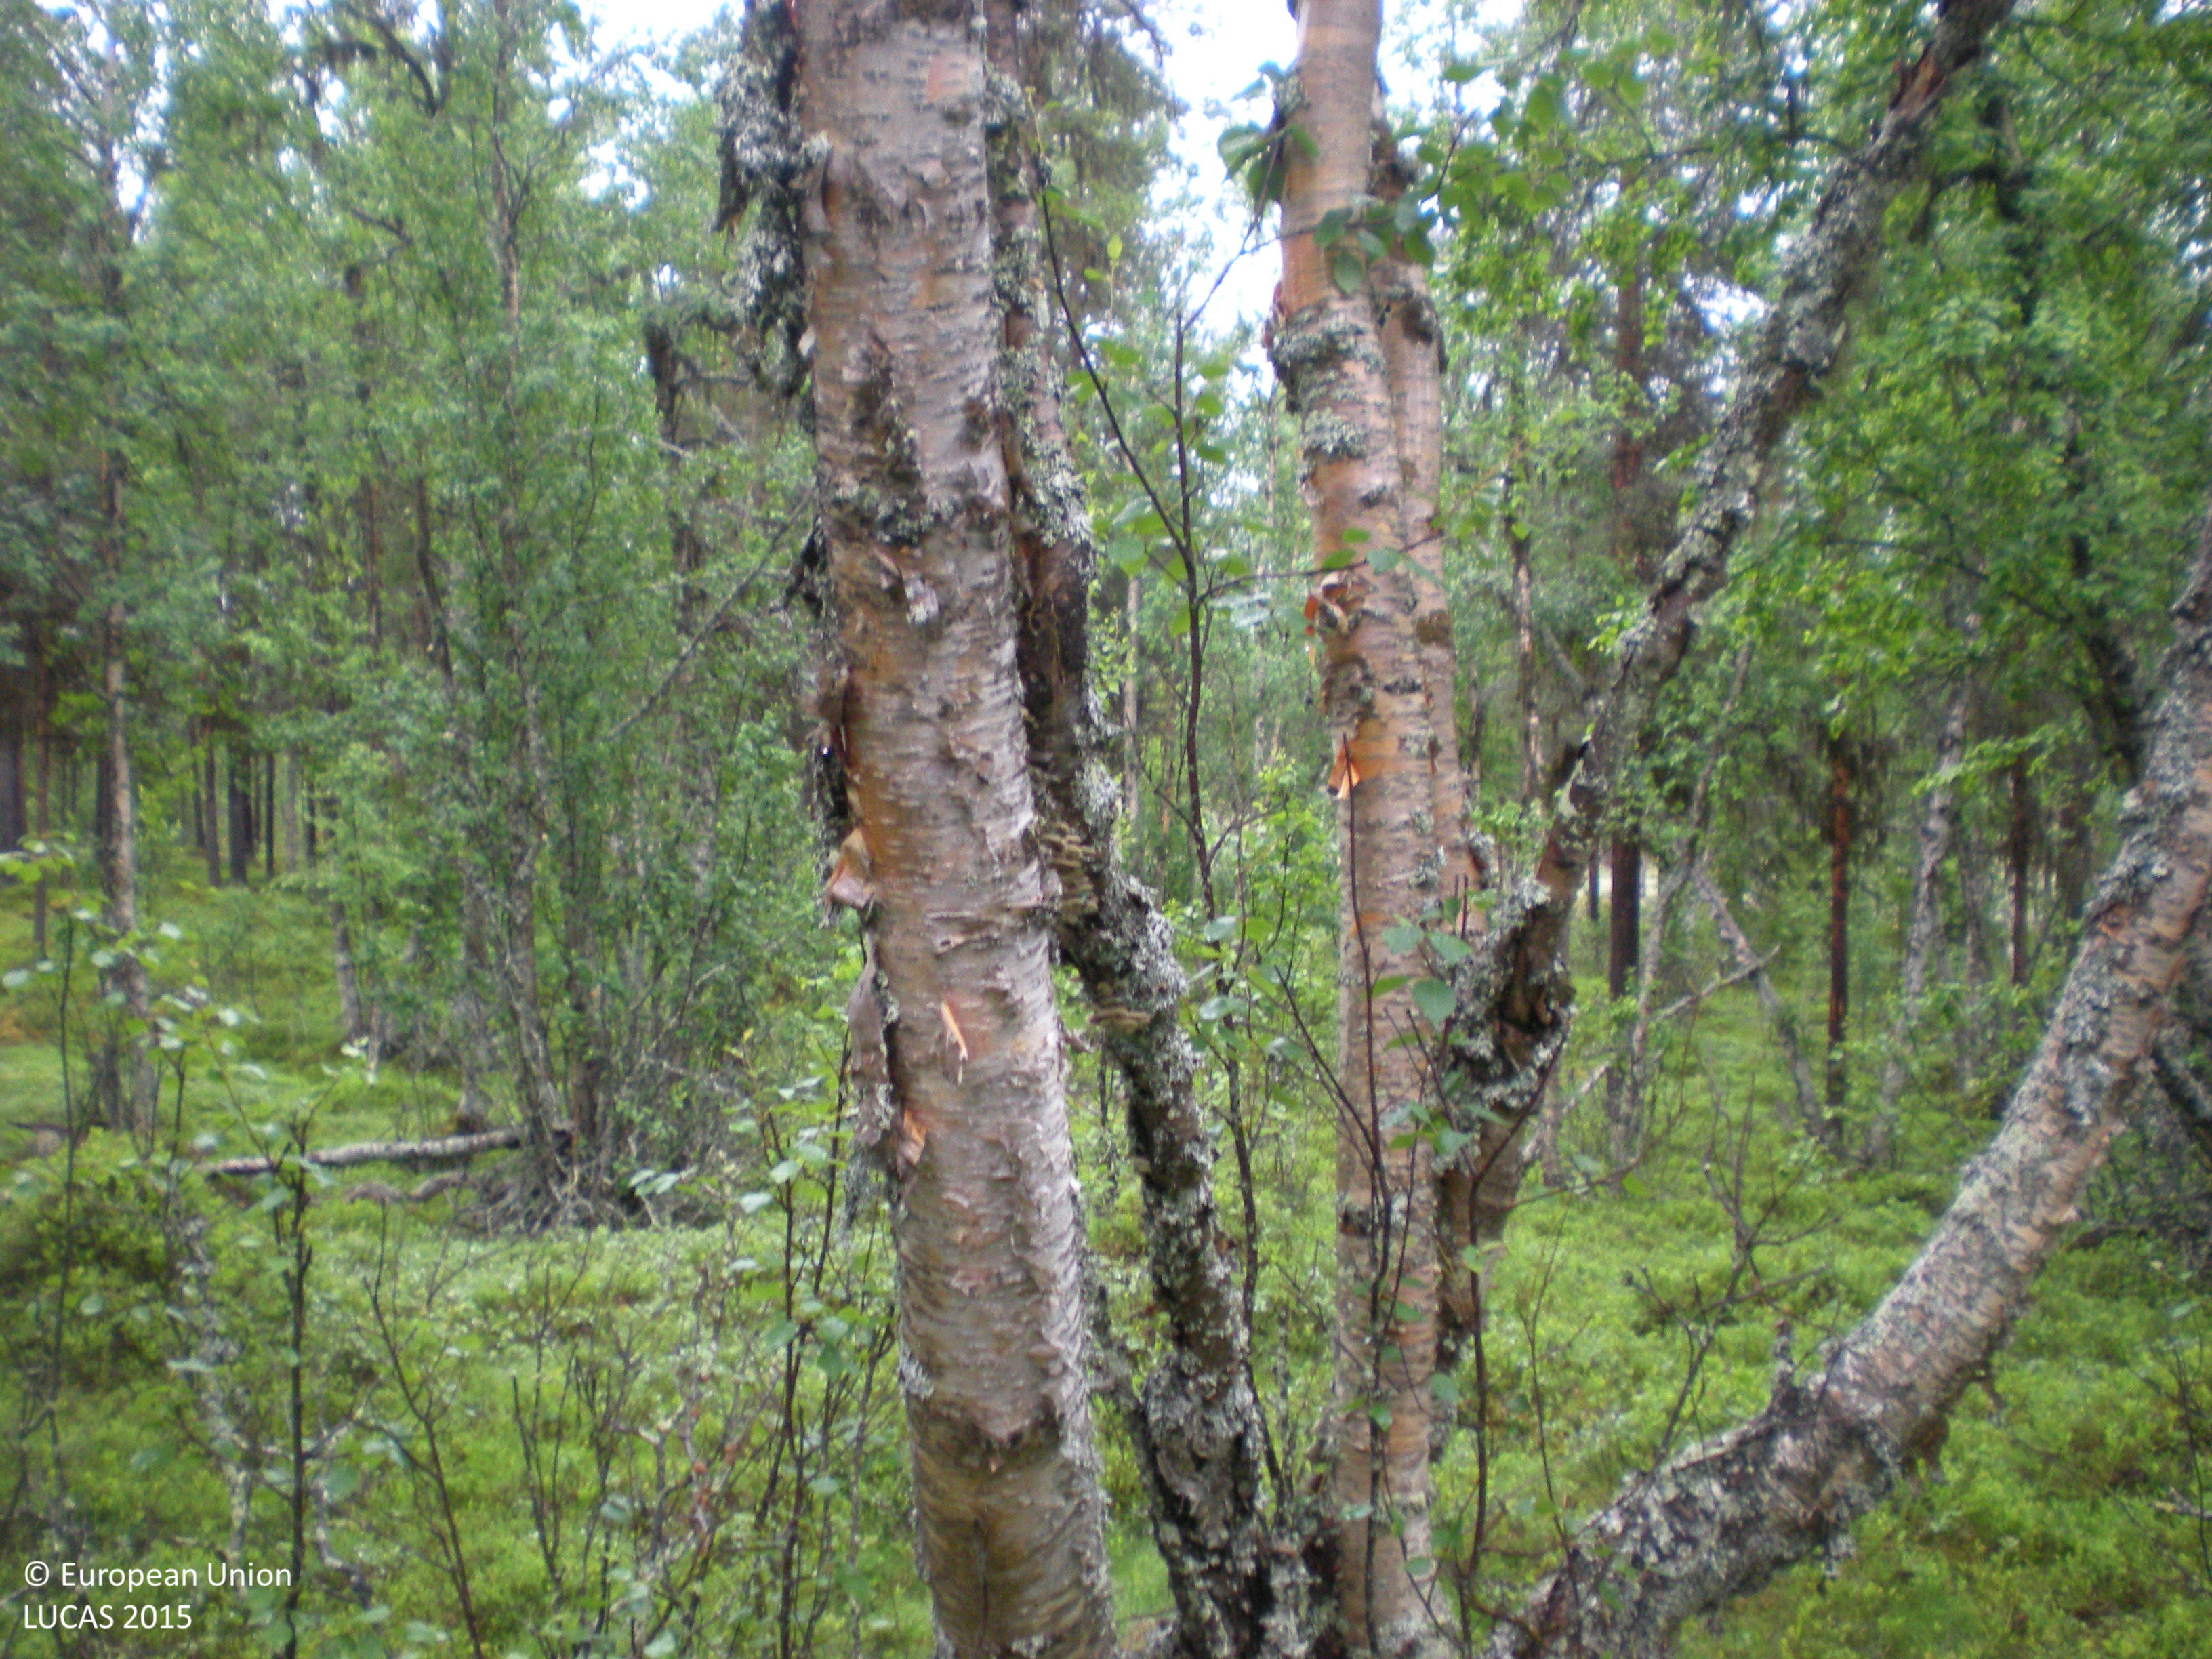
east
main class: Woodland
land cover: Pine dominated mixed woodland
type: boreal forest
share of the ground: 50 - 75 %
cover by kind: coniferous forest trees 40 %, broadleaved forest trees 25 %, shrubs 25 %, herbaceous plants 5 %, lichens and mosses 5 %
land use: Forestry
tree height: > 5 m
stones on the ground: 25 - 50 %
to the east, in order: Pine dominated mixed woodland; Tracks; Pine dominated mixed woodland; Tracks; Pine dominated mixed woodland
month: July
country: SE
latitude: 66.0078
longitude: 18.1323
